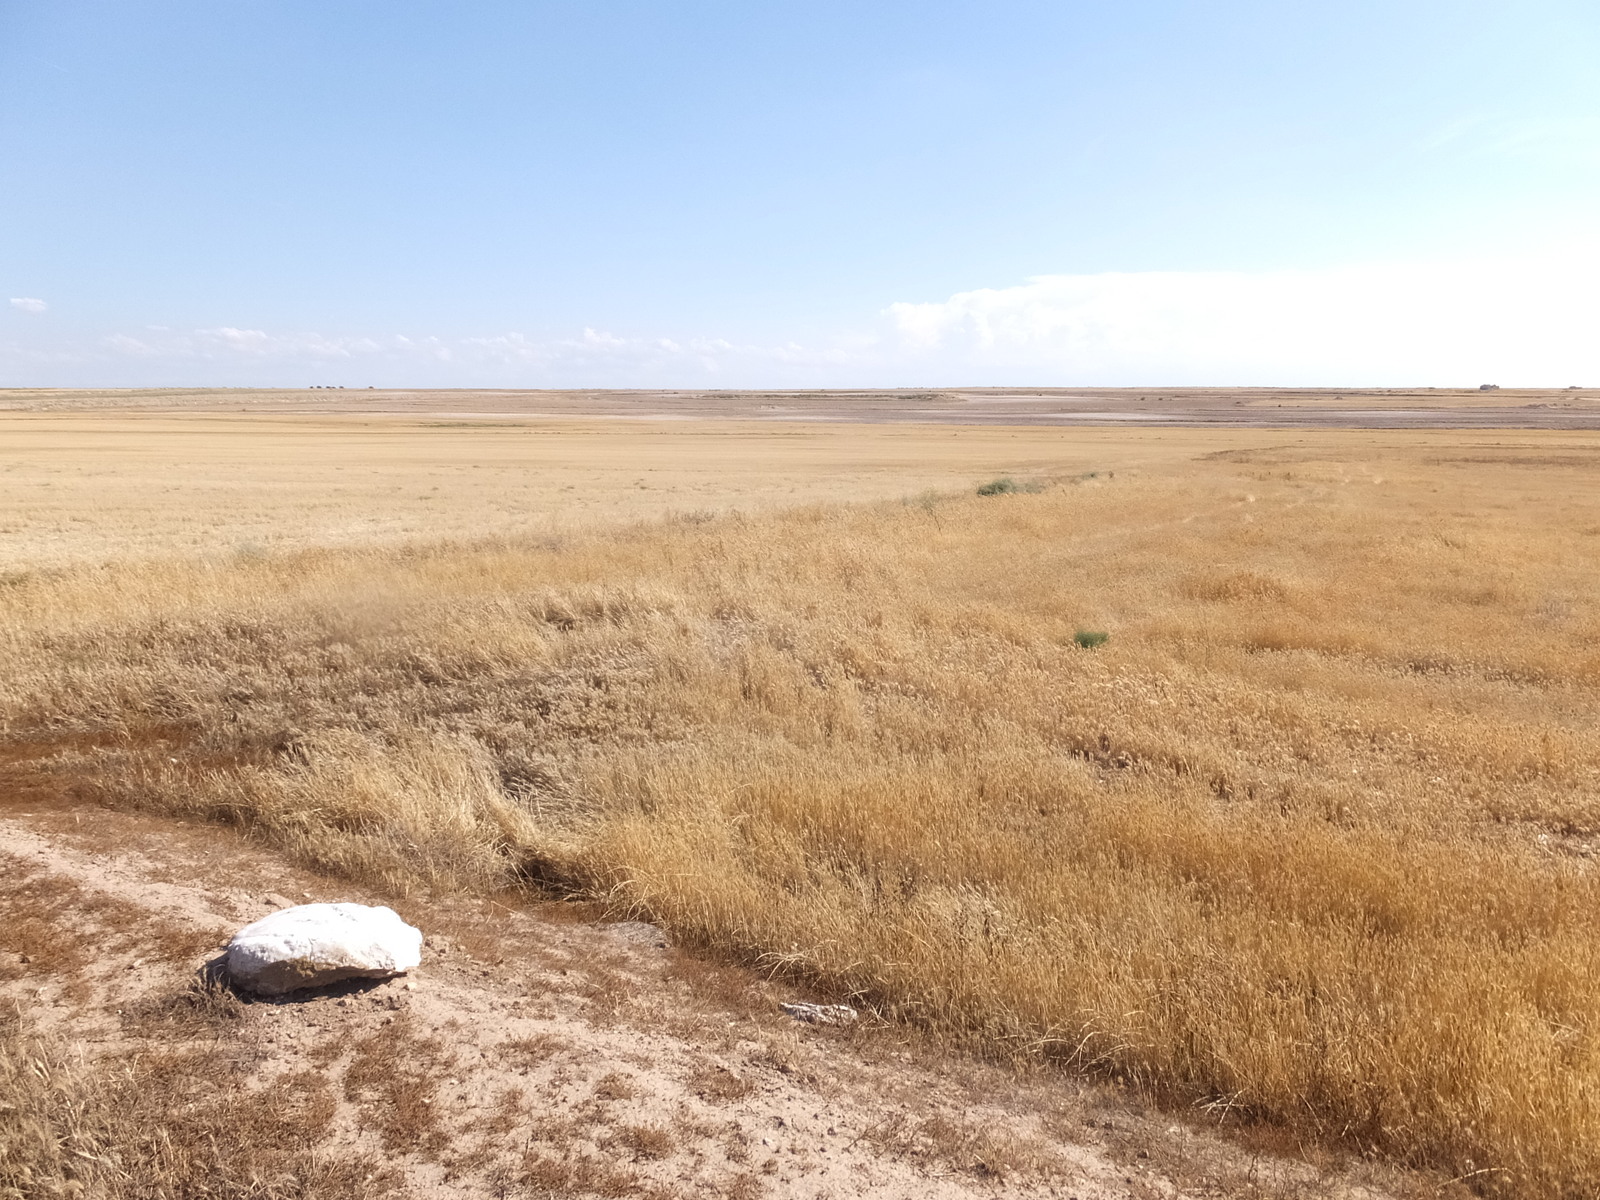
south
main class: Grassland
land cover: Grassland without tree/shrub cover
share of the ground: > 75 %
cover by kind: herbaceous plants 100 %
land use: Abandoned areas
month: June
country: ES
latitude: 41.4225
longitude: -0.0771
